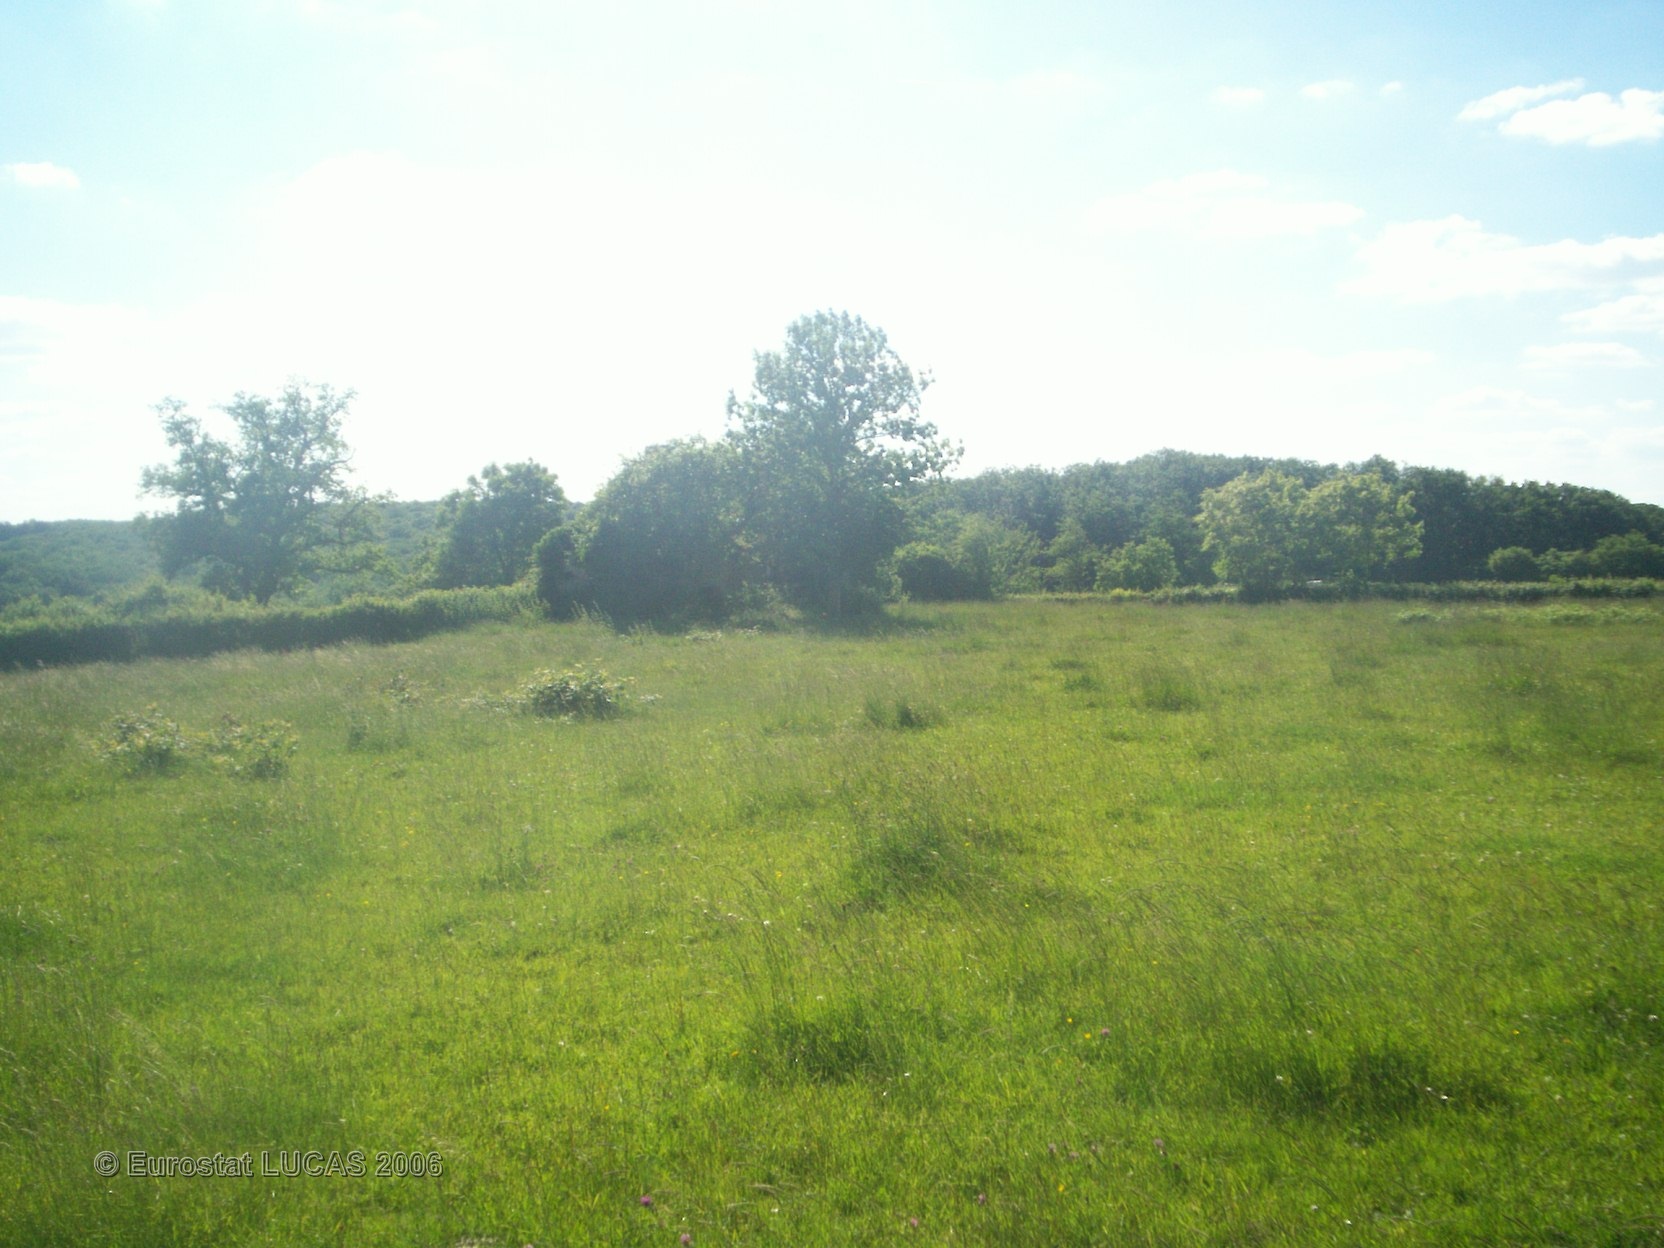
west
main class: Grassland
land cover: Grassland with sparse tree/shrub cover
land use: Agriculture (excluding fallow land and kitchen gardens)
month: June
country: FR
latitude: 46.2963
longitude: 3.1829
